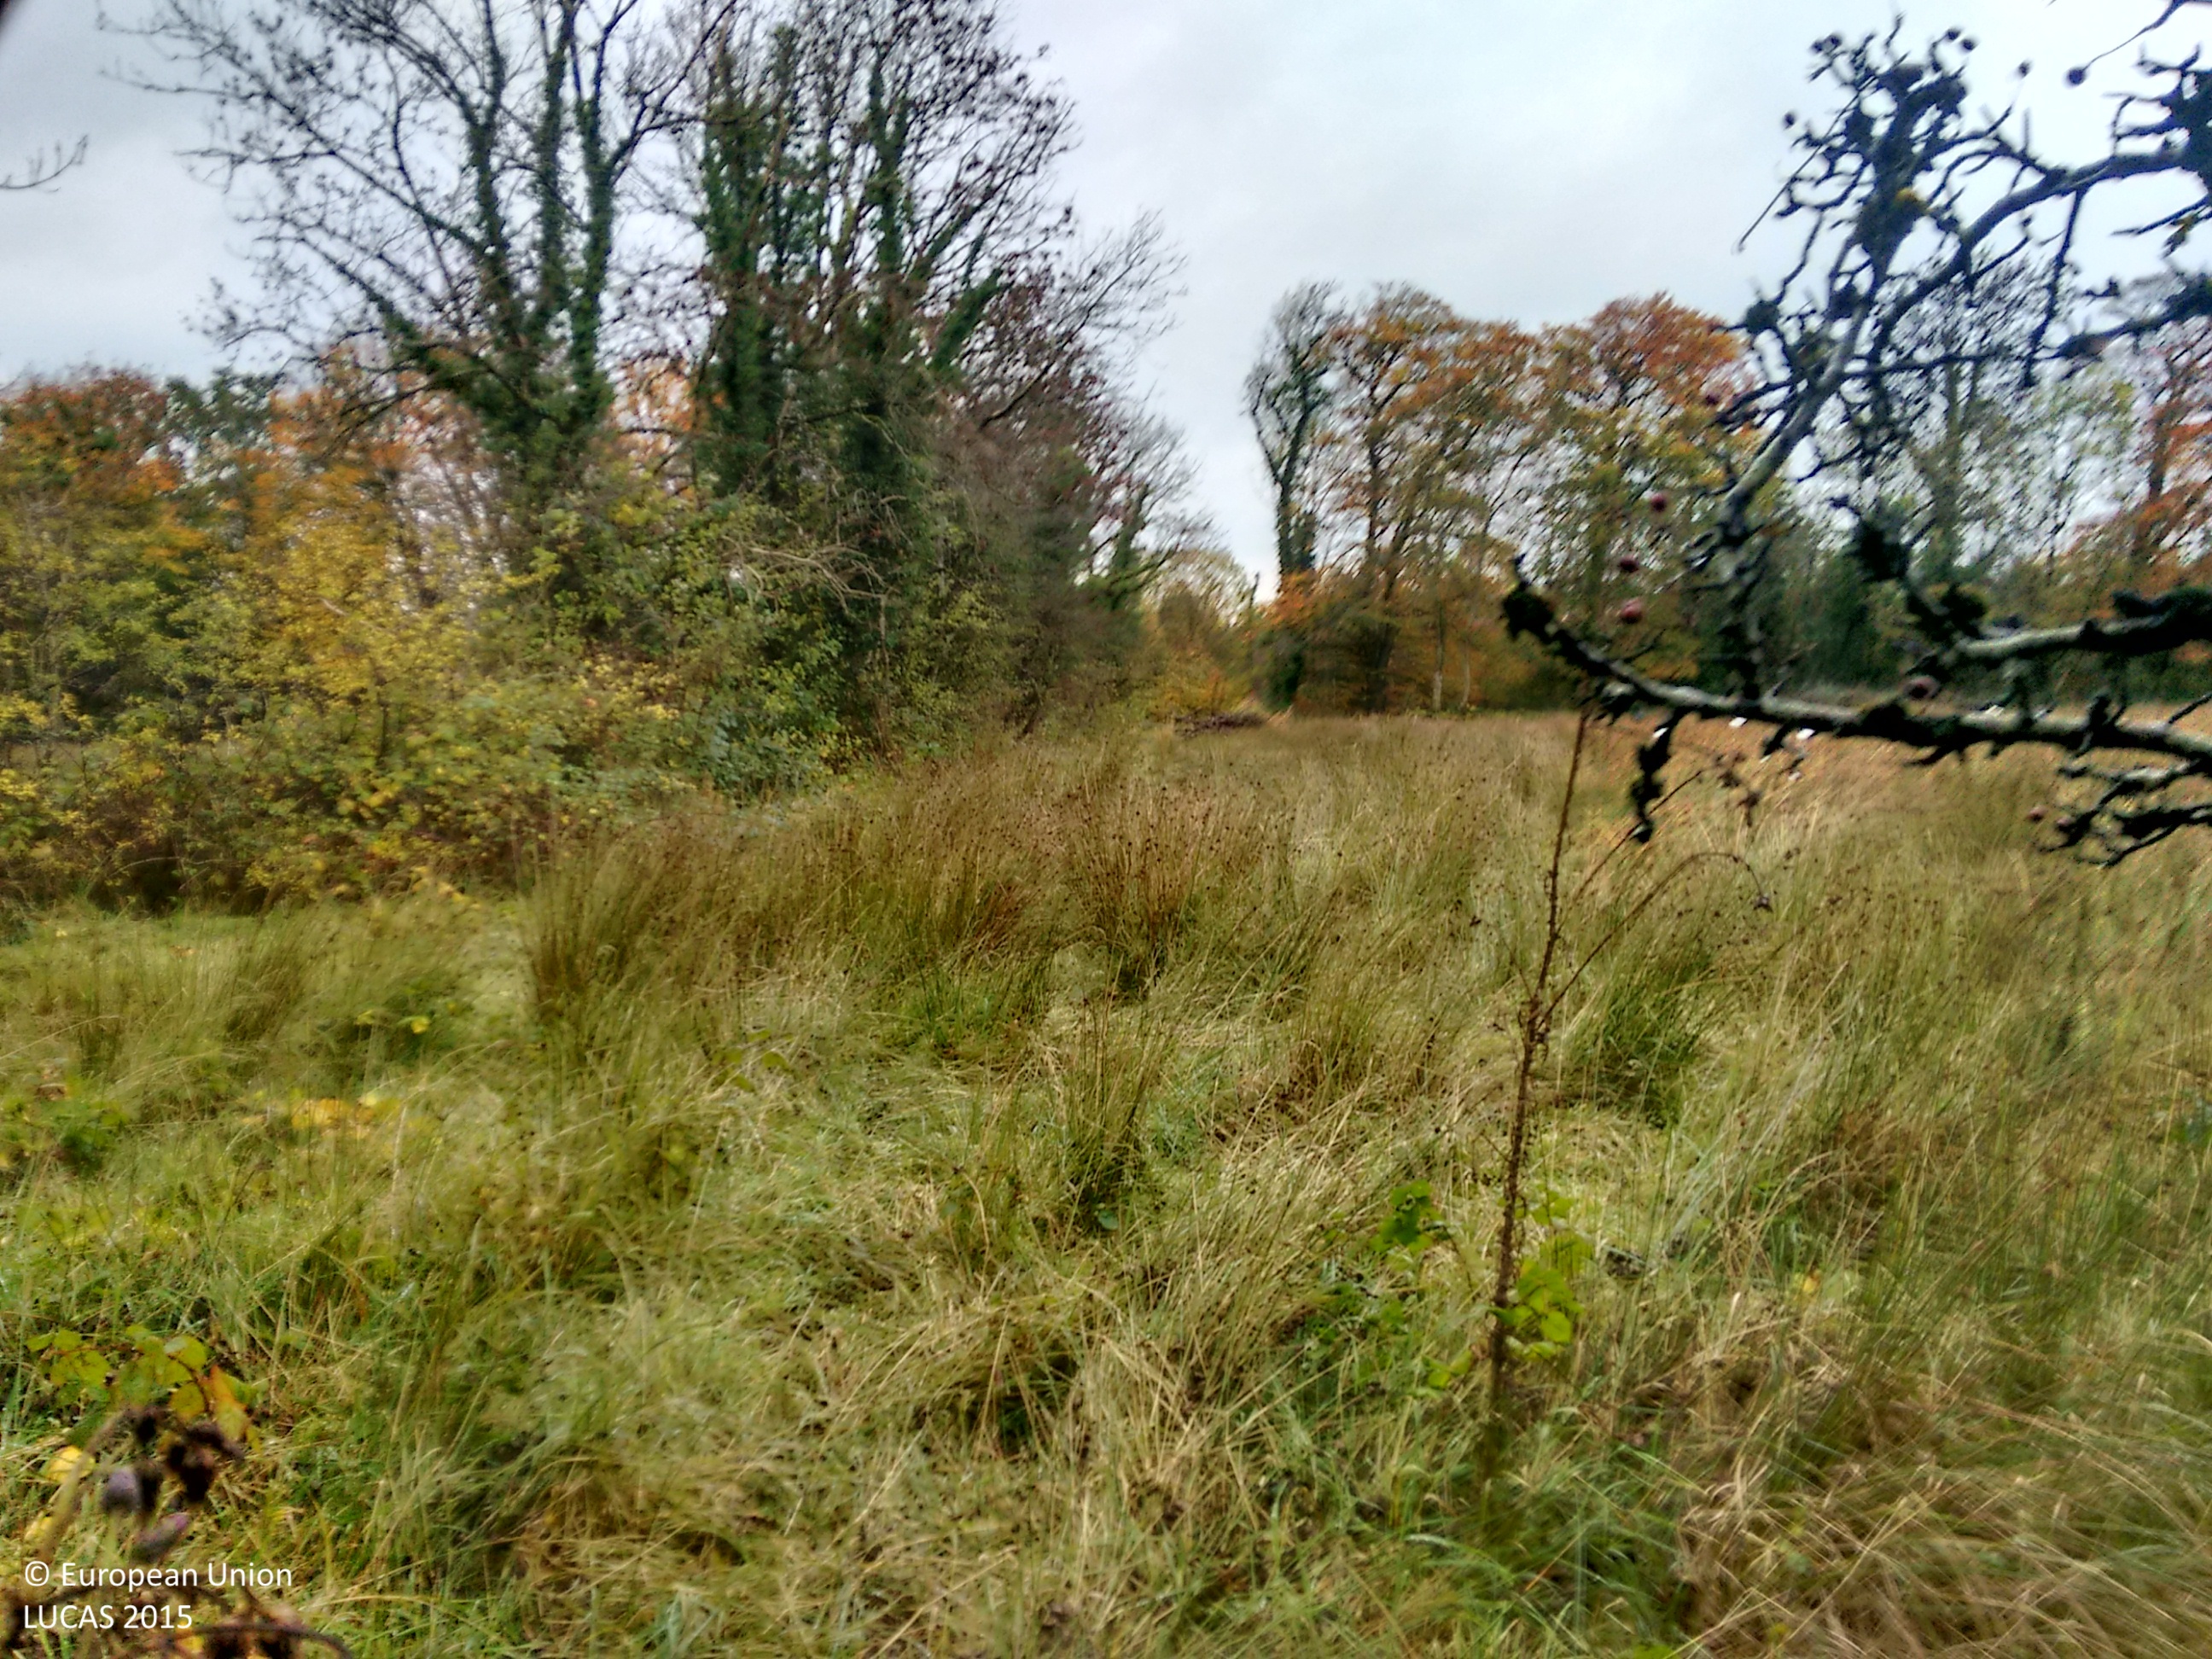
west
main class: Grassland
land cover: Grassland without tree/shrub cover
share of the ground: > 75 %
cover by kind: herbaceous plants 100 %
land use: Agriculture (excluding fallow land and kitchen gardens)
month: October
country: IE
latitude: 53.8704
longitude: -8.0775
